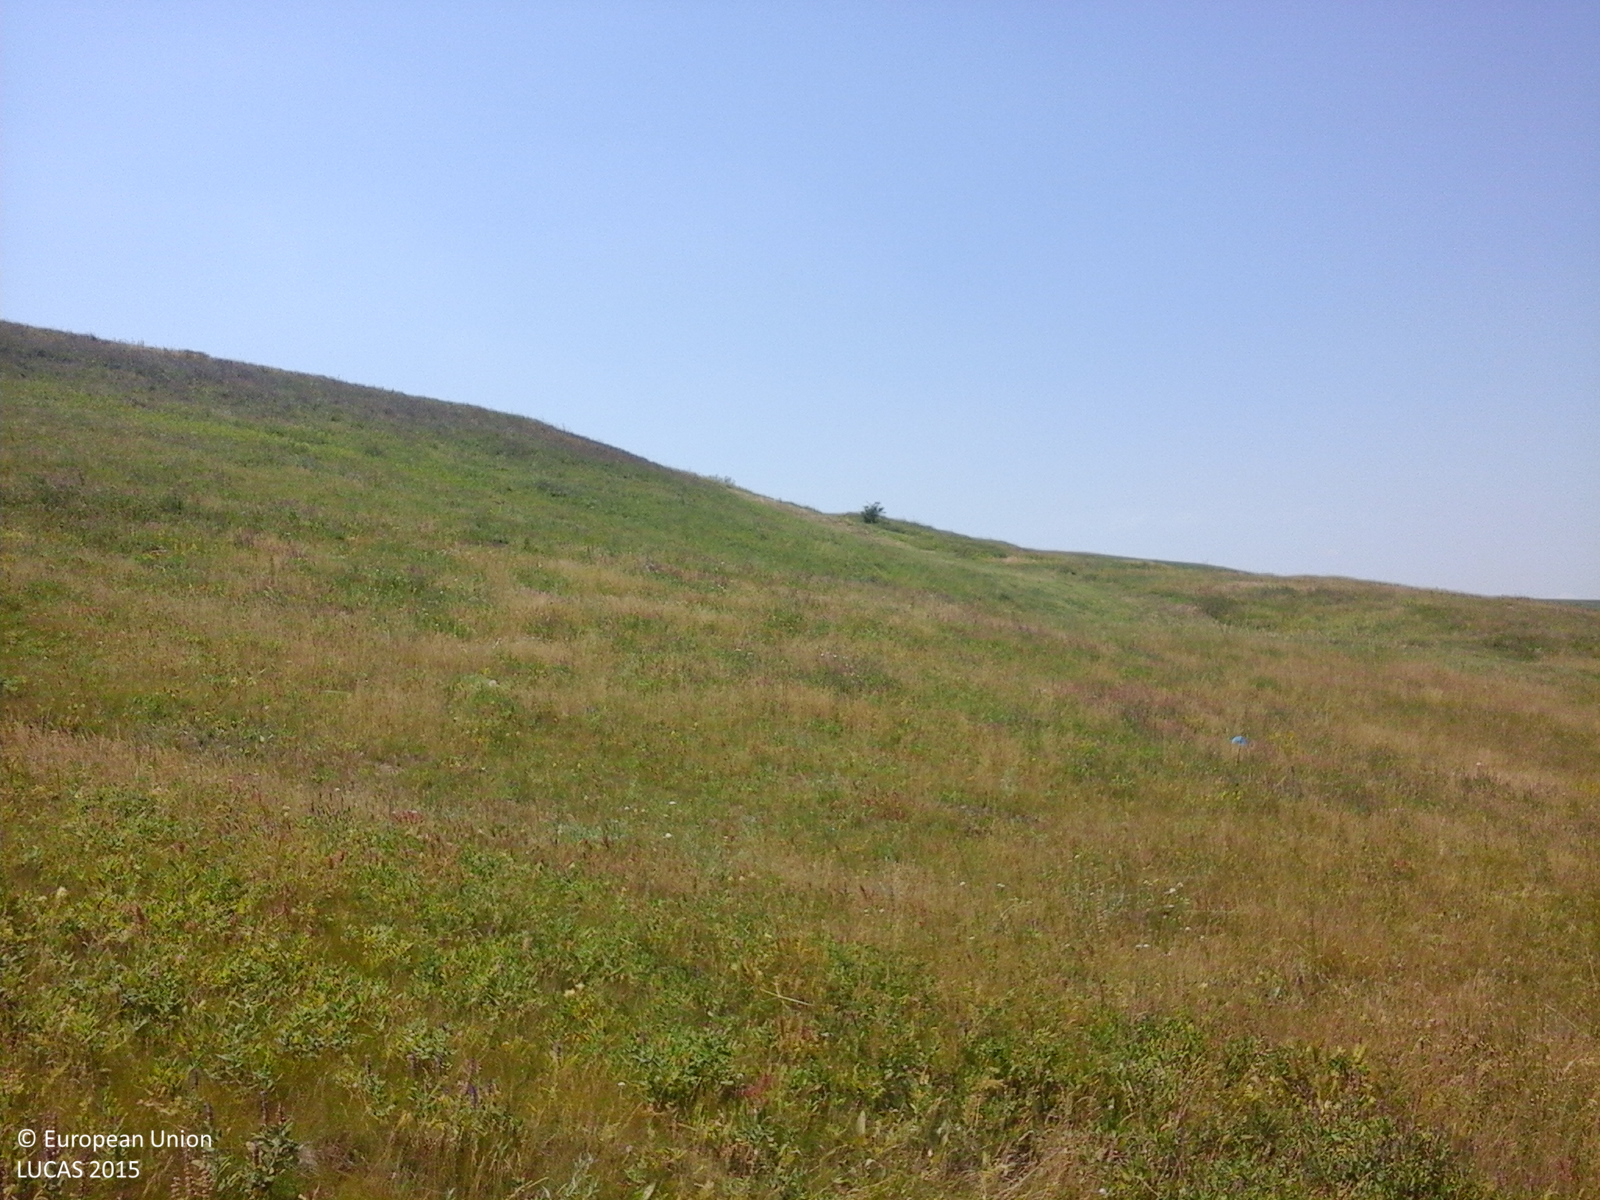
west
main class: Grassland
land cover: Grassland without tree/shrub cover
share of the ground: > 75 %
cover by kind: herbaceous plants 100 %
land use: Agriculture (excluding fallow land and kitchen gardens)
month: June
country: RO
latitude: 47.4461
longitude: 27.2031
